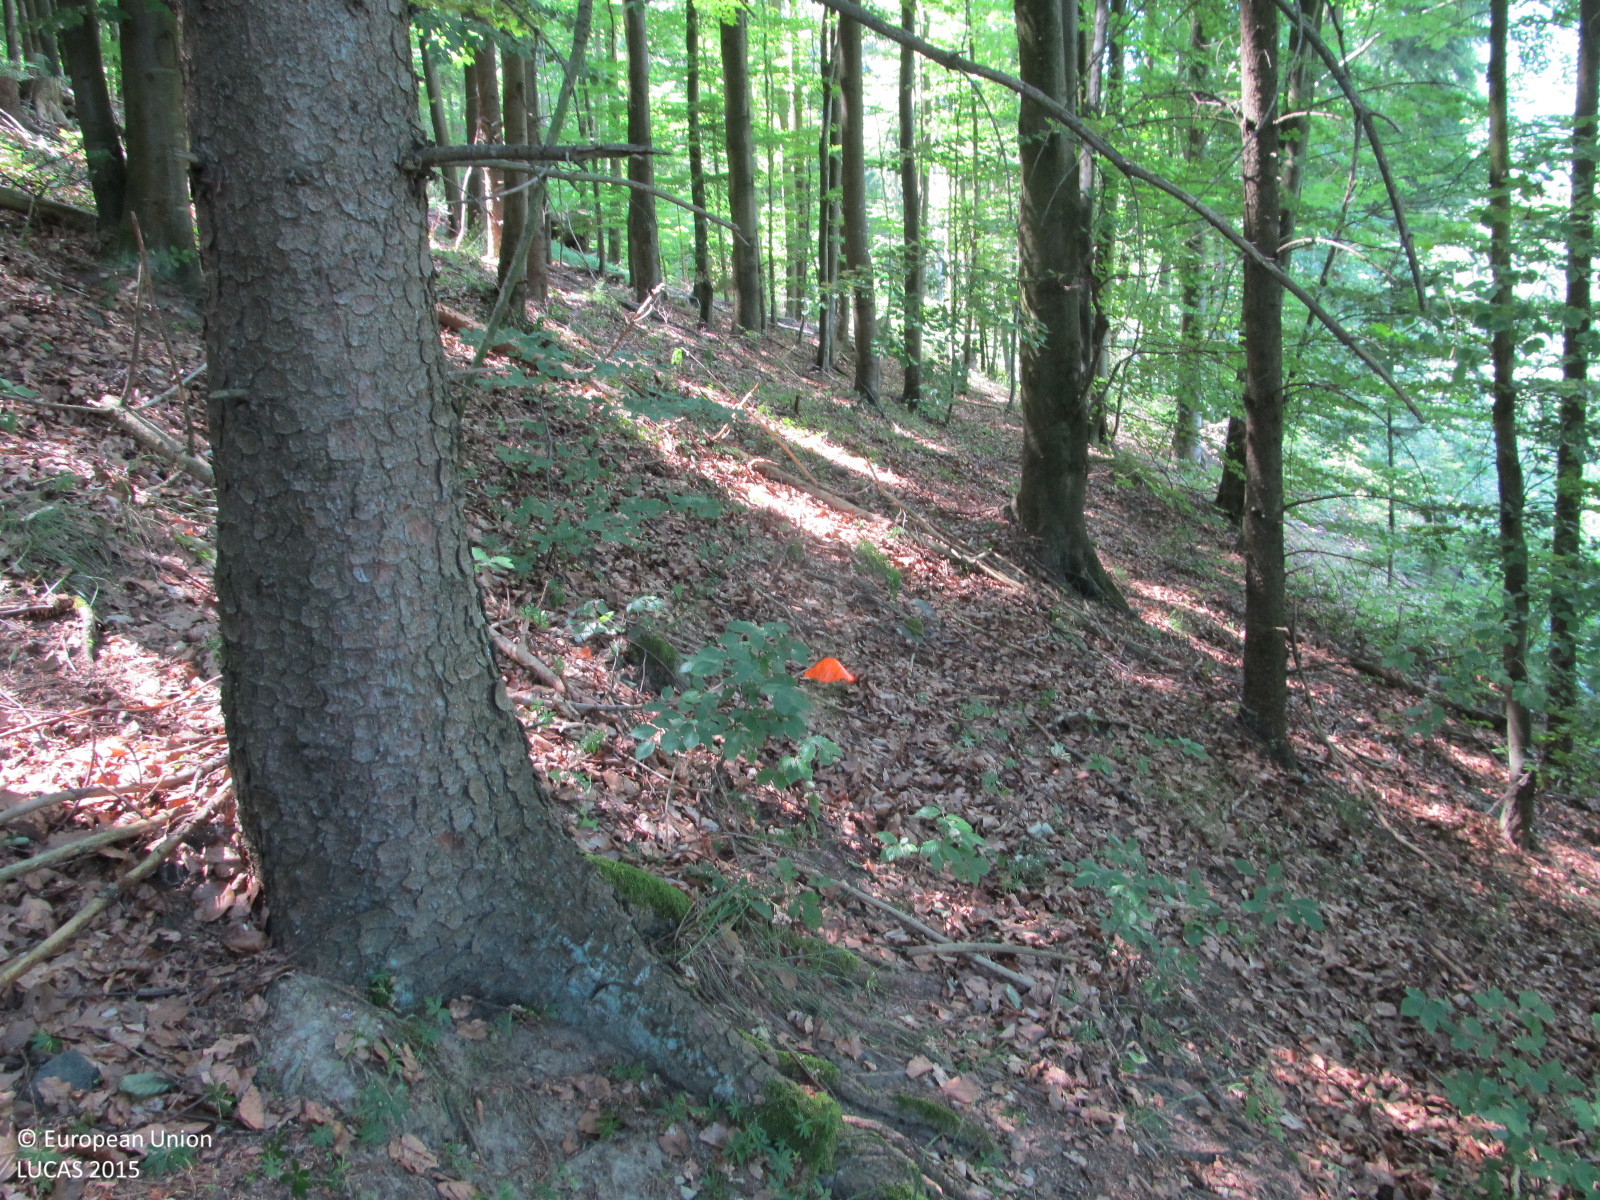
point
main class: Woodland
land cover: Spruce dominated mixed woodland
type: hemiboreal forest and nemoral coniferous forest and mixed broadleaved-coniferous forest
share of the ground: > 75 %
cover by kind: broadleaved forest trees 50 %, coniferous forest trees 40 %, shrubs 5 %, unconsolidated bare surface 5 %
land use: Forestry
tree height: > 5 m
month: July
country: AT
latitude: 48.3085
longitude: 15.3819
